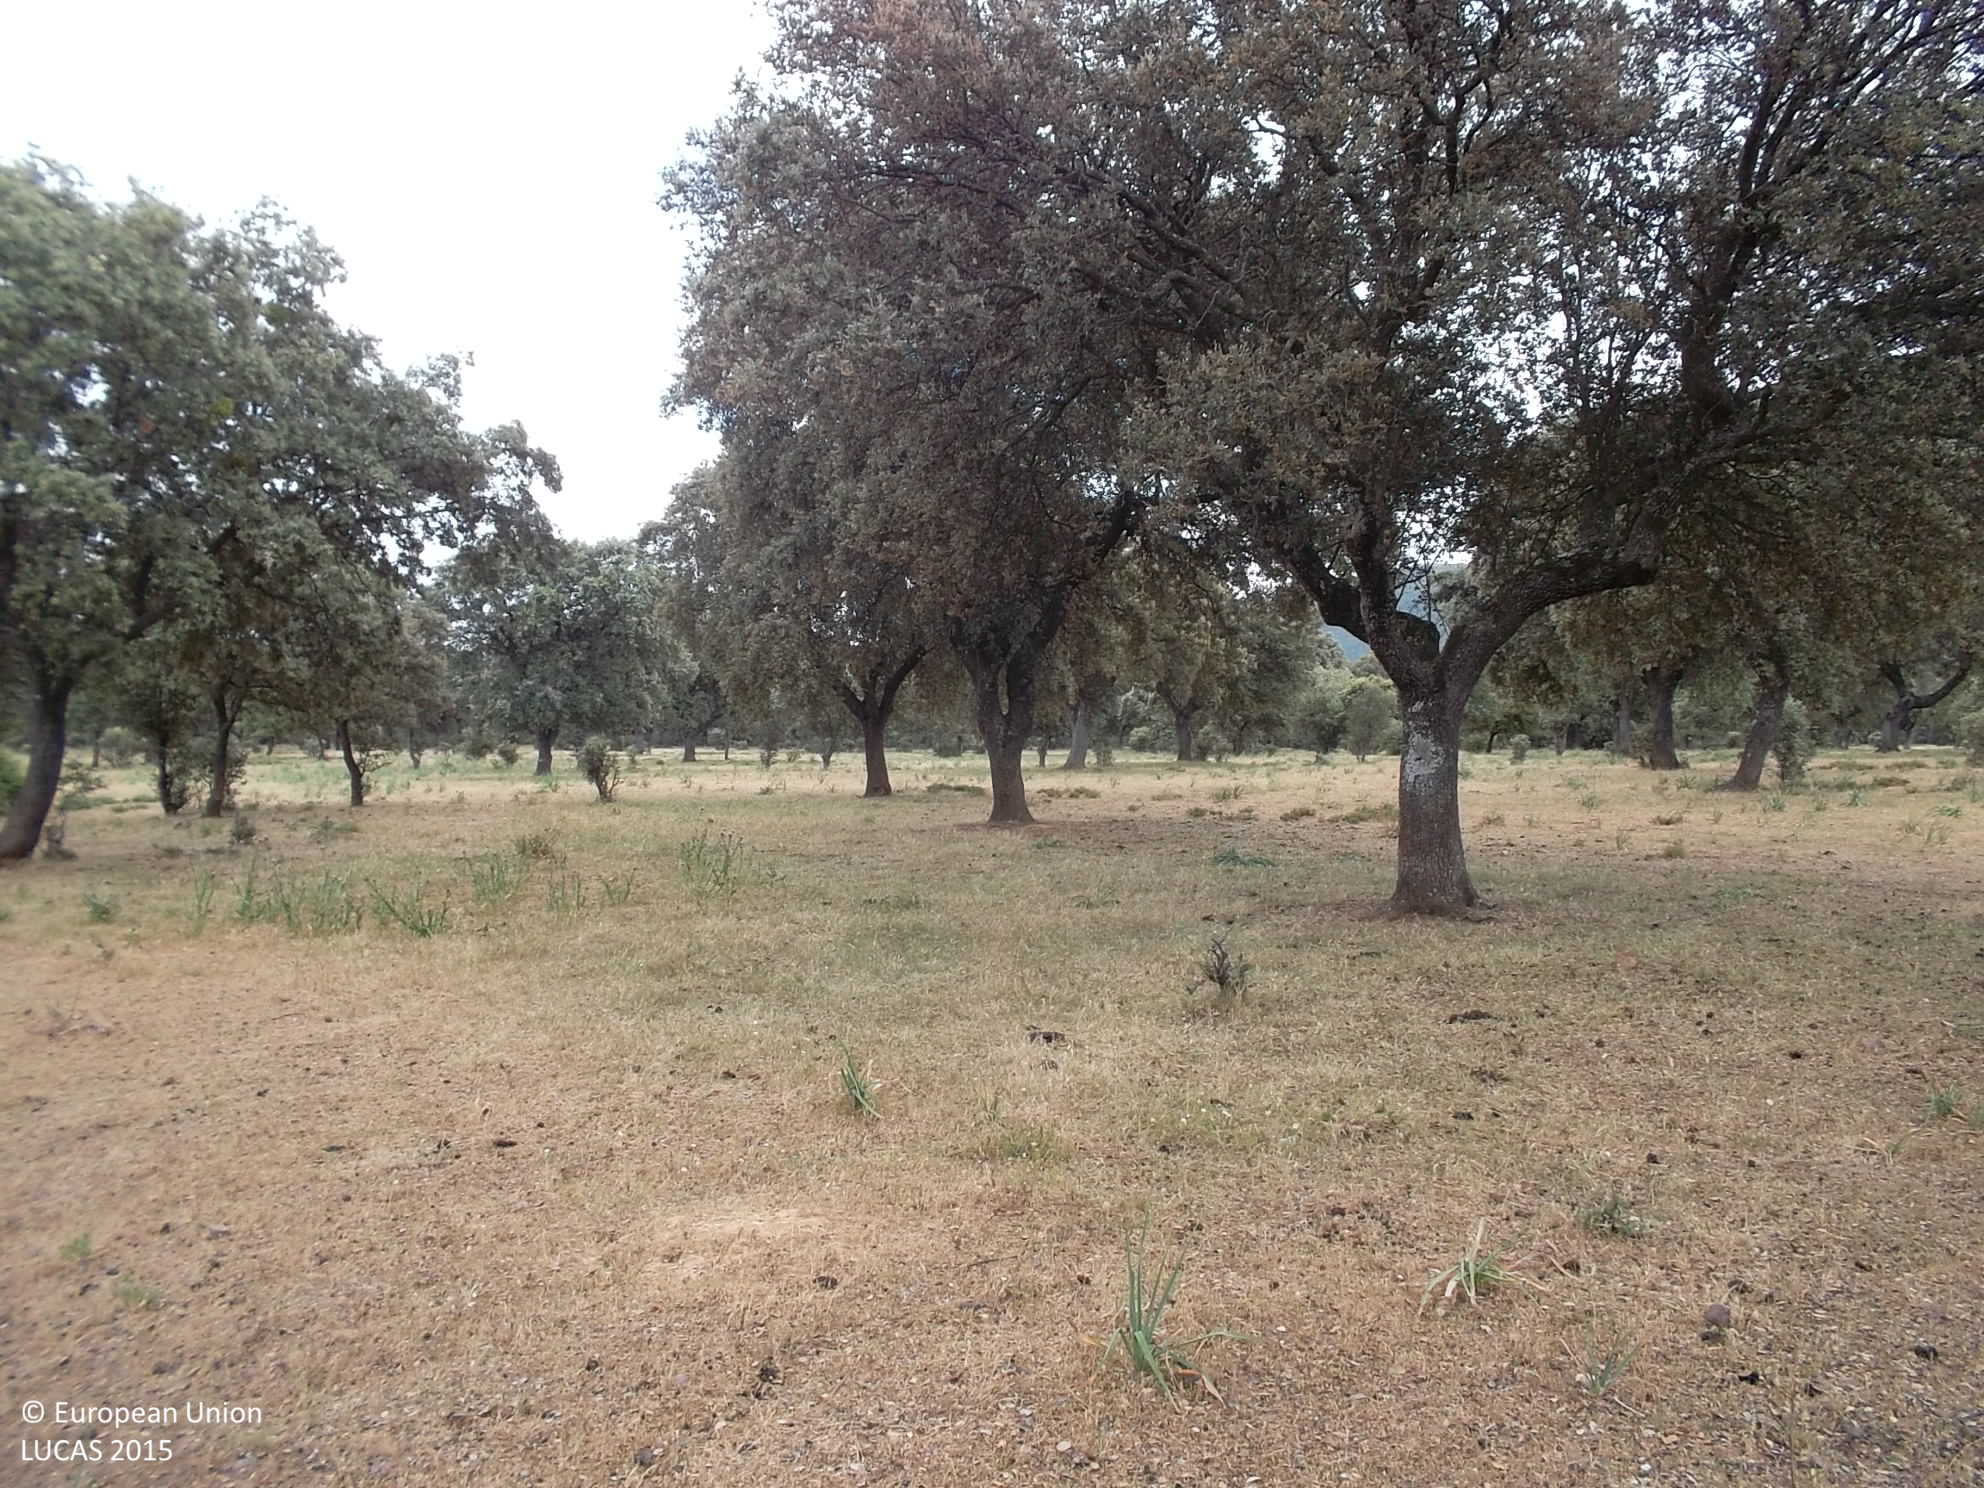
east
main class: Woodland
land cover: Broadleaved woodland
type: broadleaved evergreen forest
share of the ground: 25 - 50 %
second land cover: Spontaneously vegetated surfaces
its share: > 75 %
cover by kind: herbaceous plants 50 %, broadleaved forest trees 40 %, shrubs 10 %
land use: Forestry
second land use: Agriculture (excluding fallow land and kitchen gardens)
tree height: > 5 m
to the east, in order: Broadleaved woodland; Spontaneously vegetated surfaces; Tracks; Broadleaved woodland
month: May
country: ES
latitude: 38.5710
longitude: -4.4251
